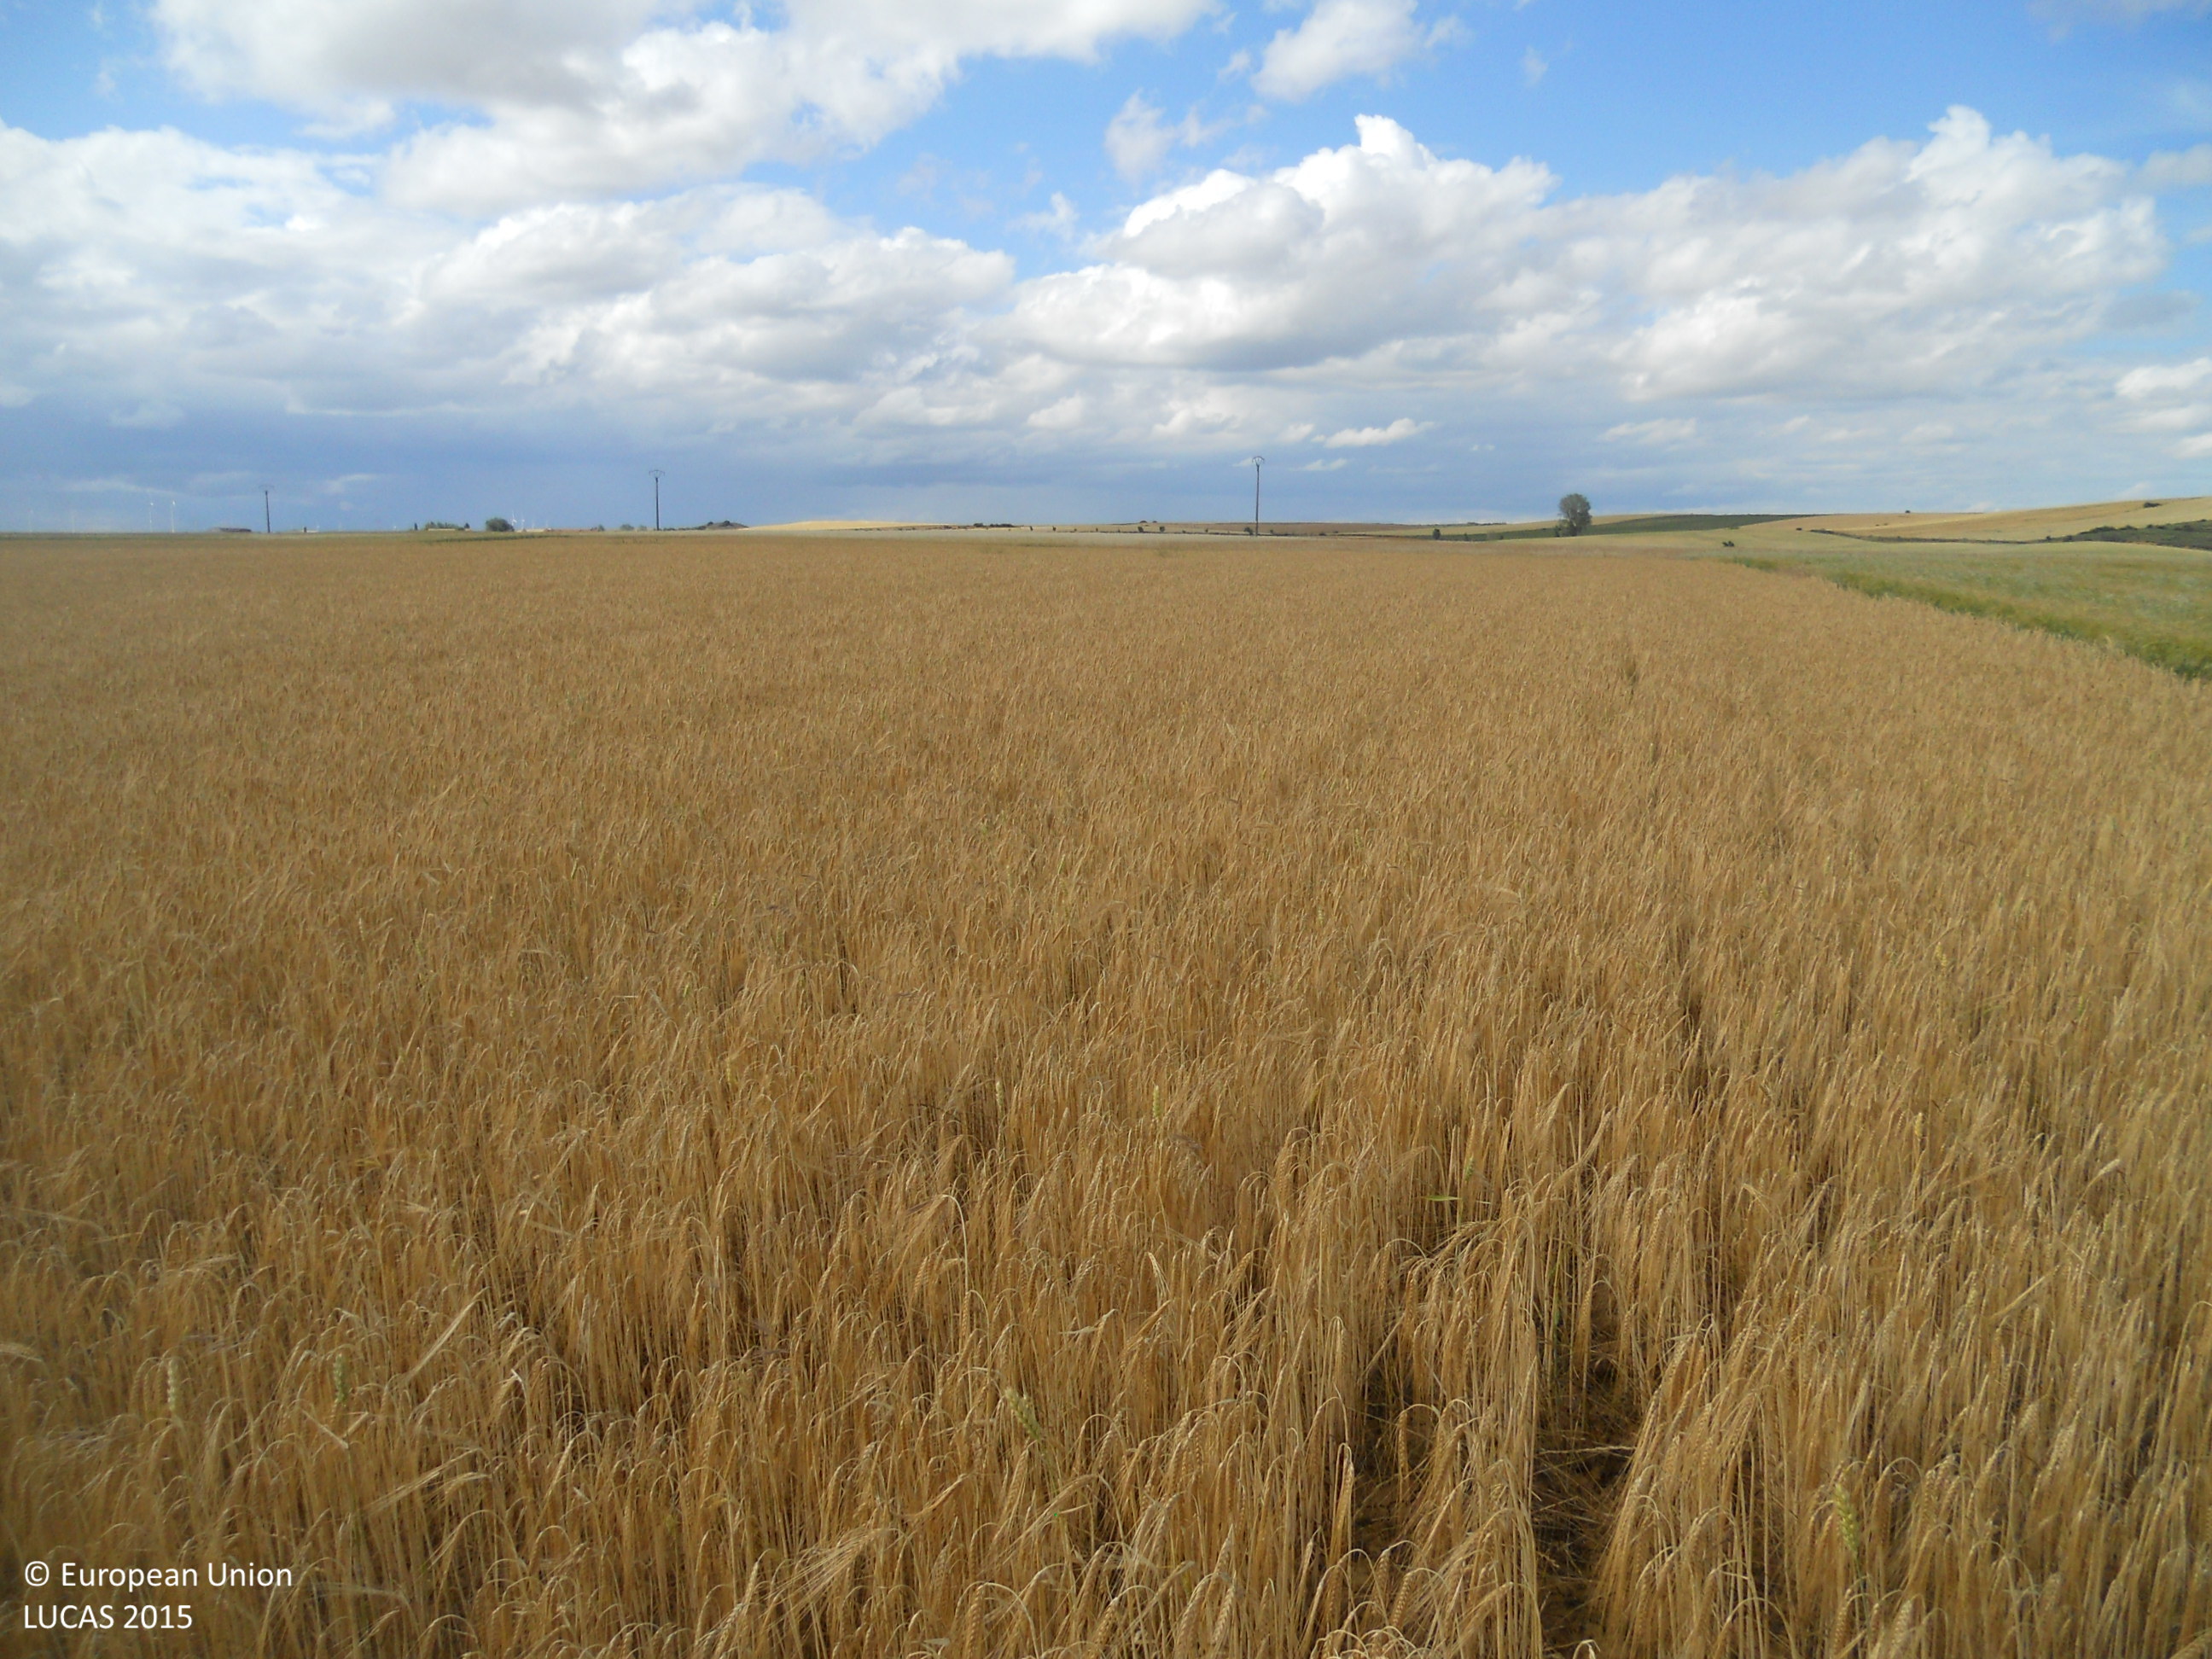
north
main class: Cropland
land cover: Barley
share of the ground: > 75 %
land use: Agriculture (excluding fallow land and kitchen gardens)
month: June
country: ES
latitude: 42.3545
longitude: -4.8797
